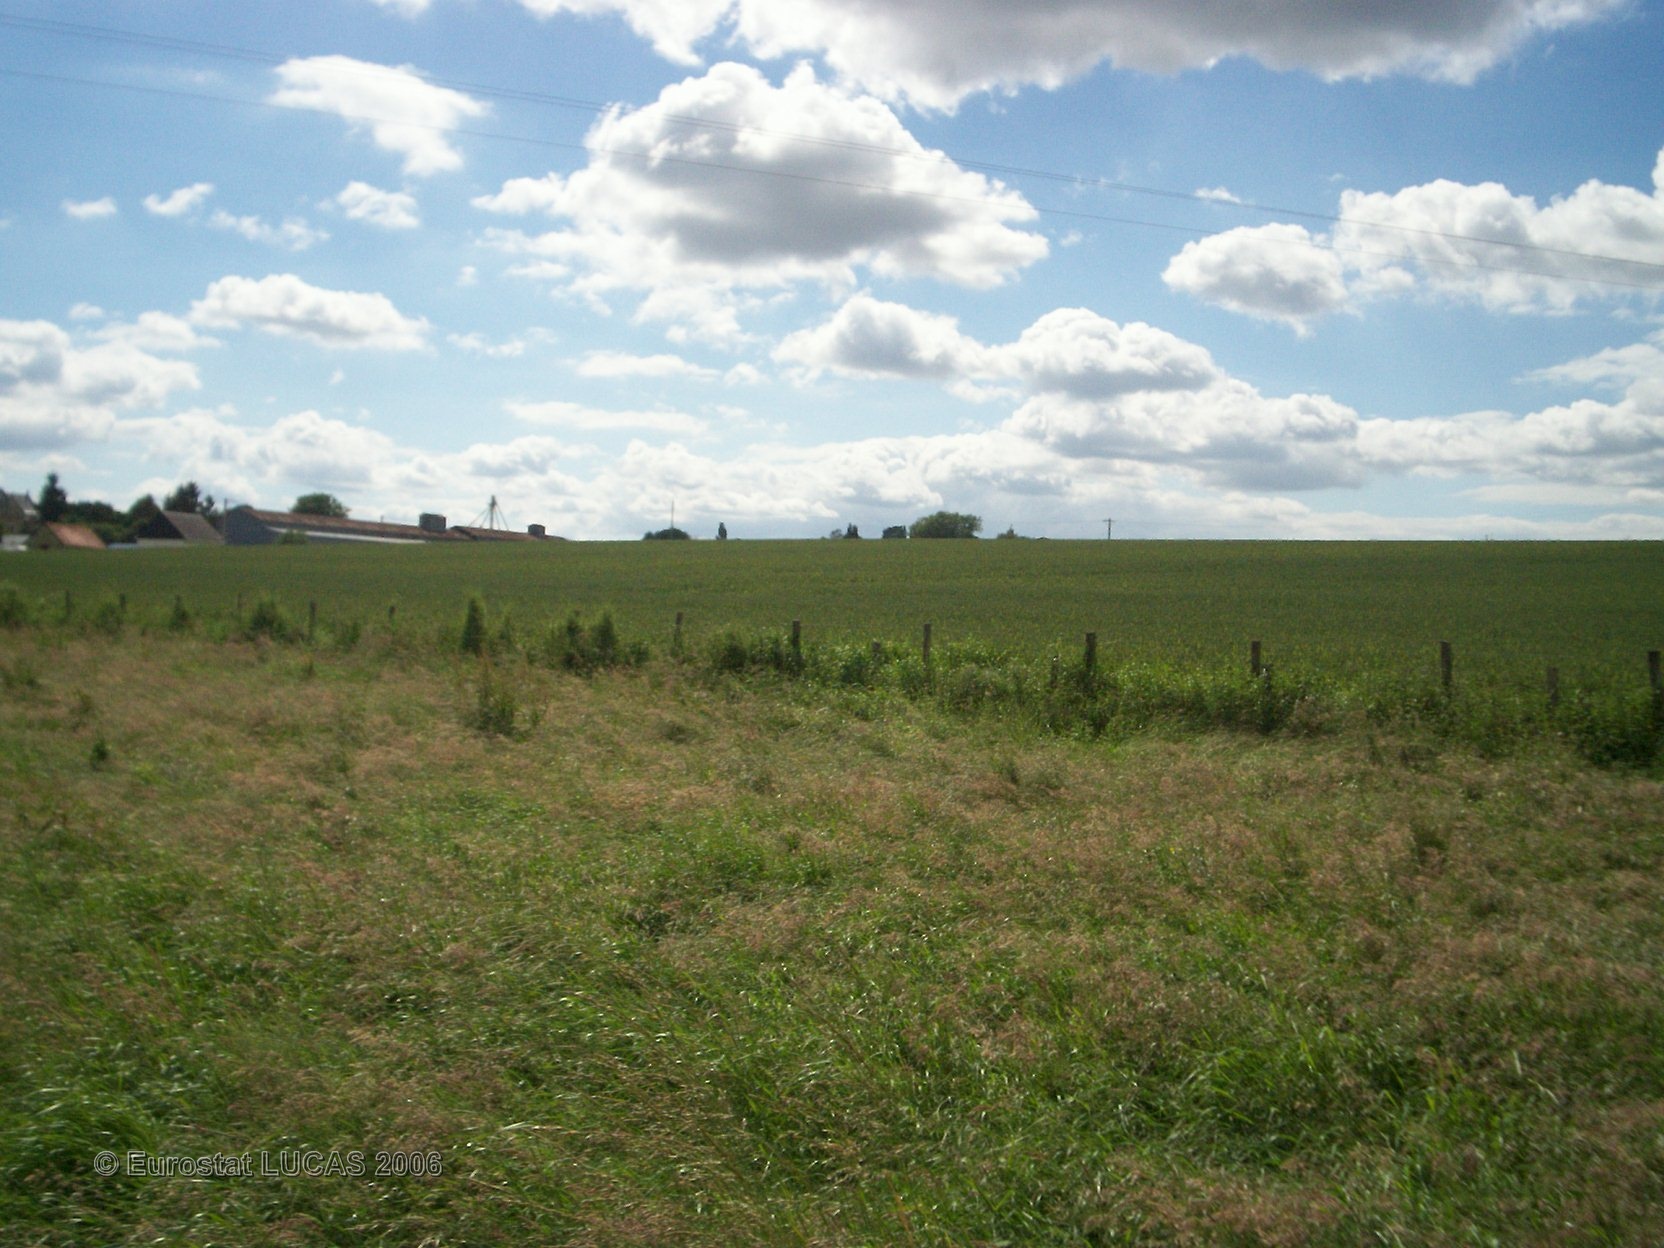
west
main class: Grassland
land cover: Grassland without tree/shrub cover
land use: Agriculture (excluding fallow land and kitchen gardens)
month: May
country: FR
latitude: 47.0641
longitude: 1.5215
